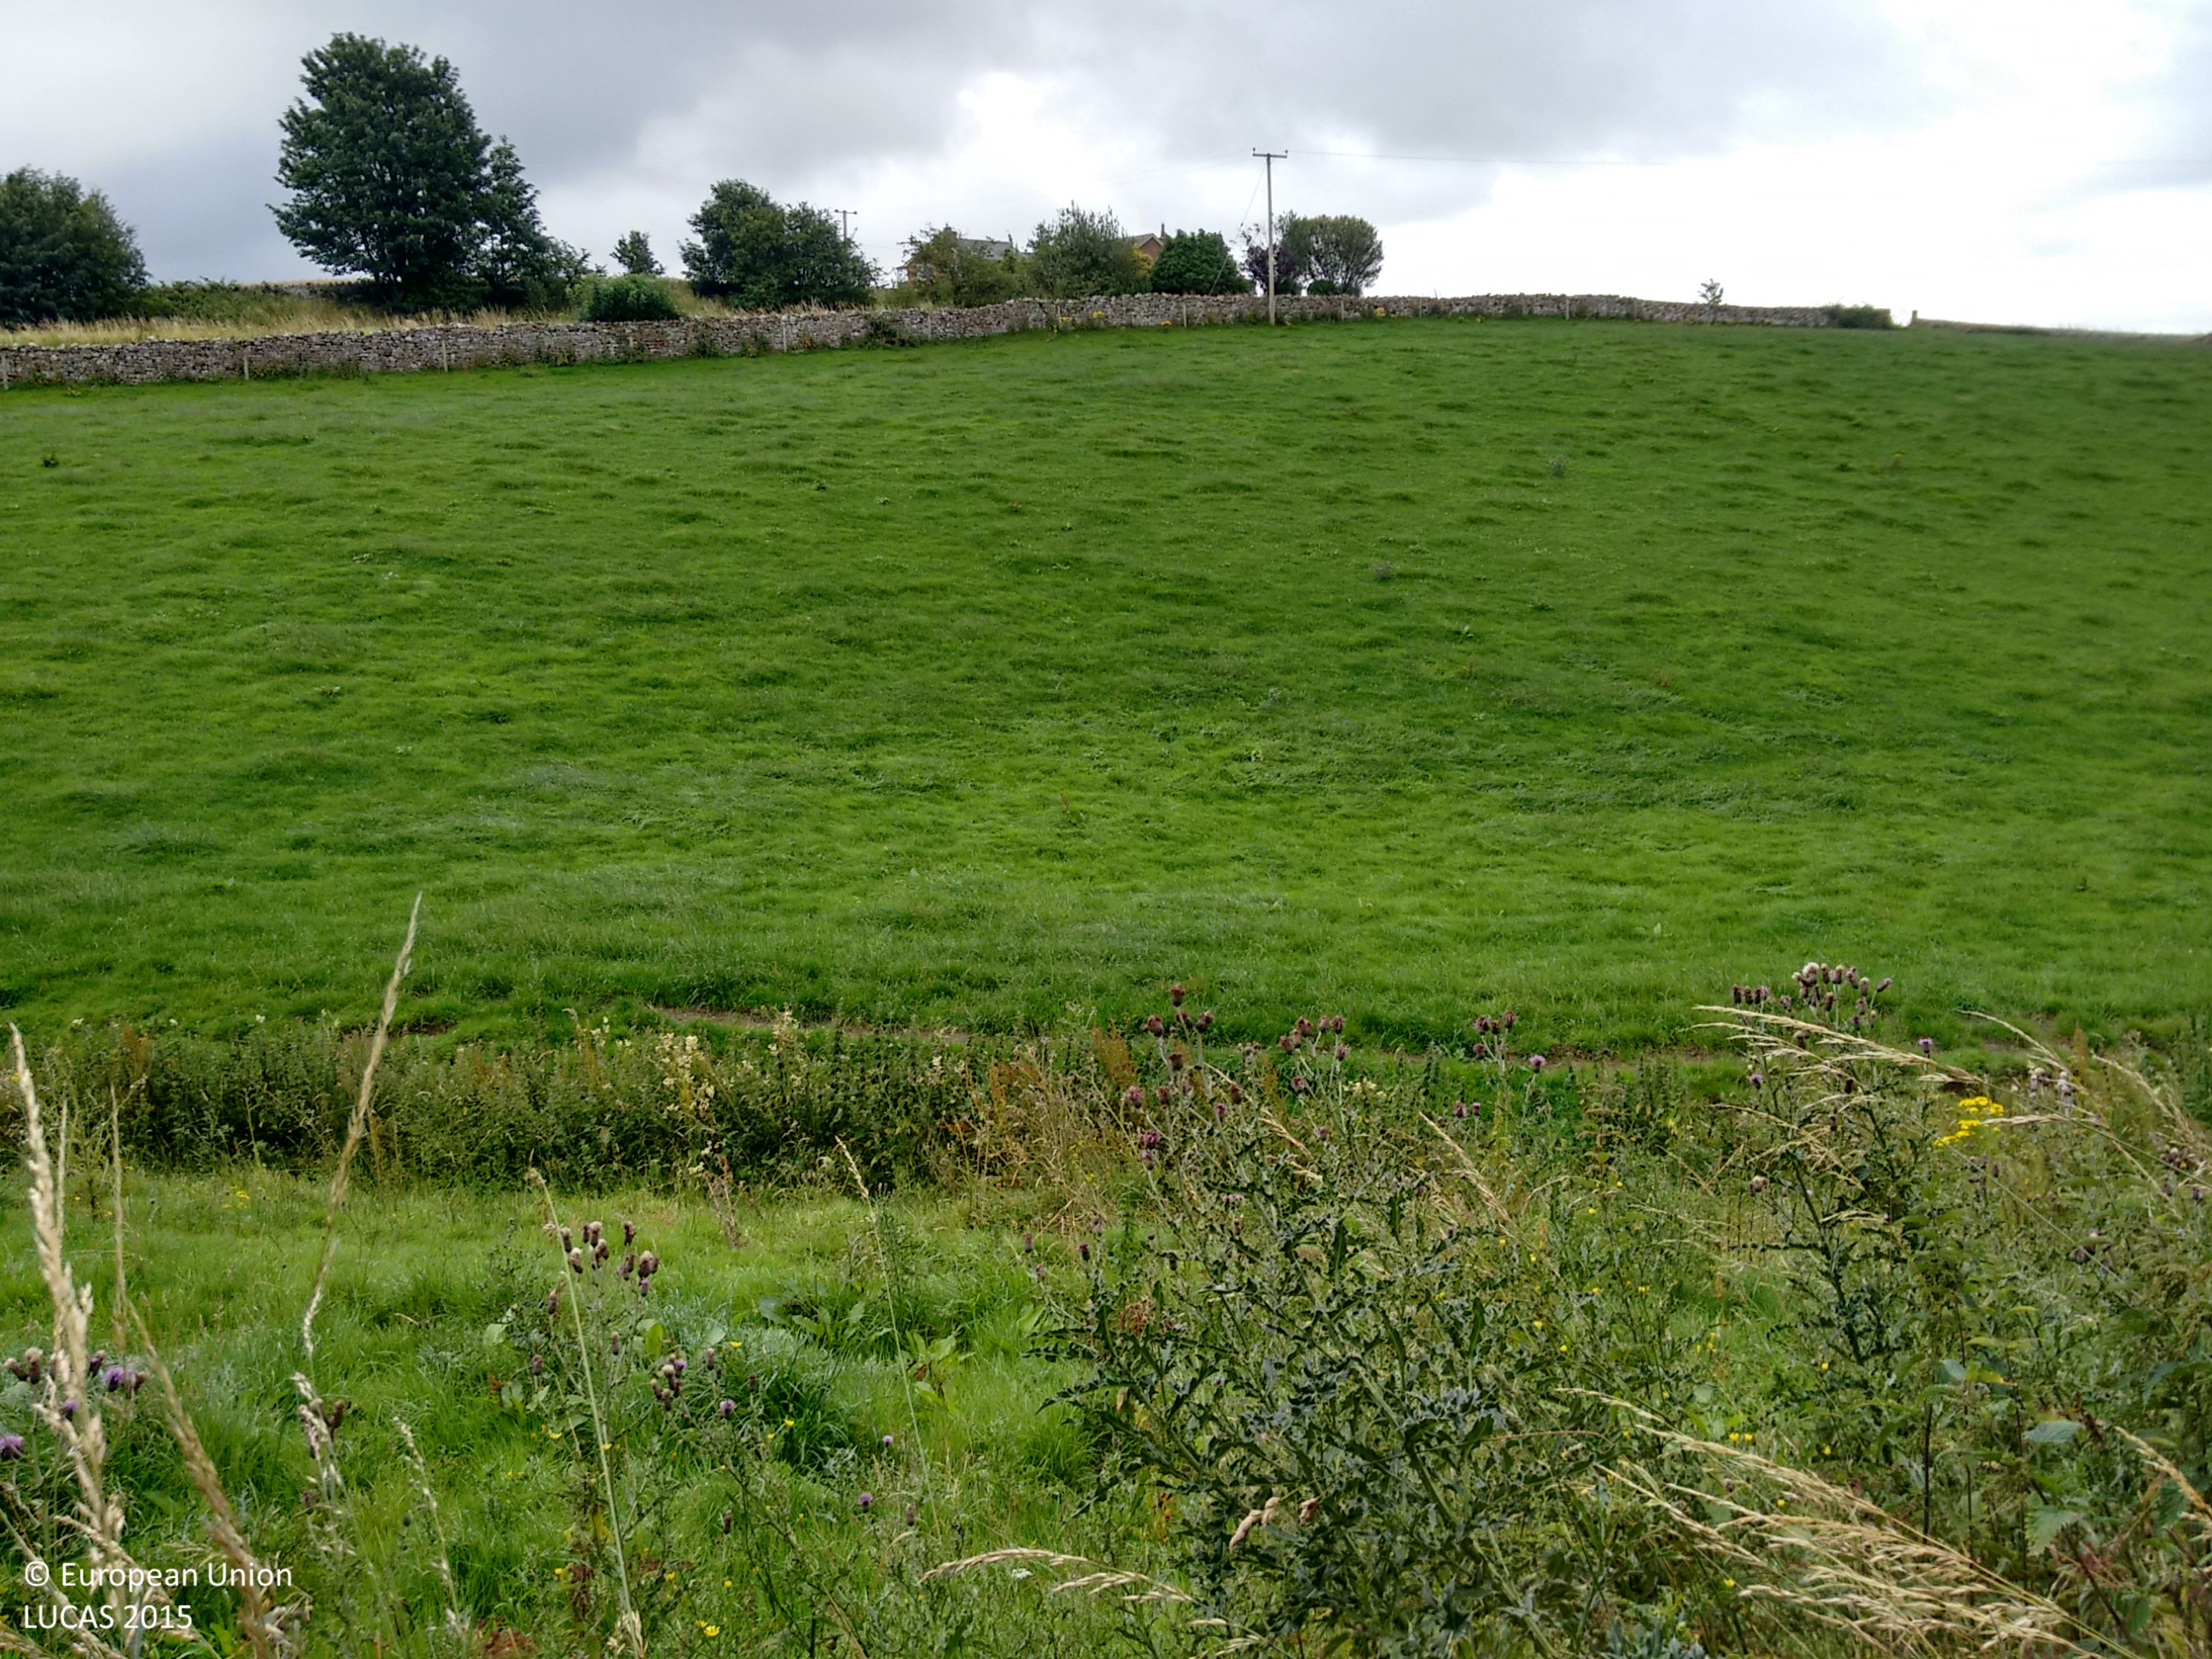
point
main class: Grassland
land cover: Grassland without tree/shrub cover
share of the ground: > 75 %
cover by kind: herbaceous plants 100 %
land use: Agriculture (excluding fallow land and kitchen gardens)
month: August
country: GB
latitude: 54.7424
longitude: -2.7901
